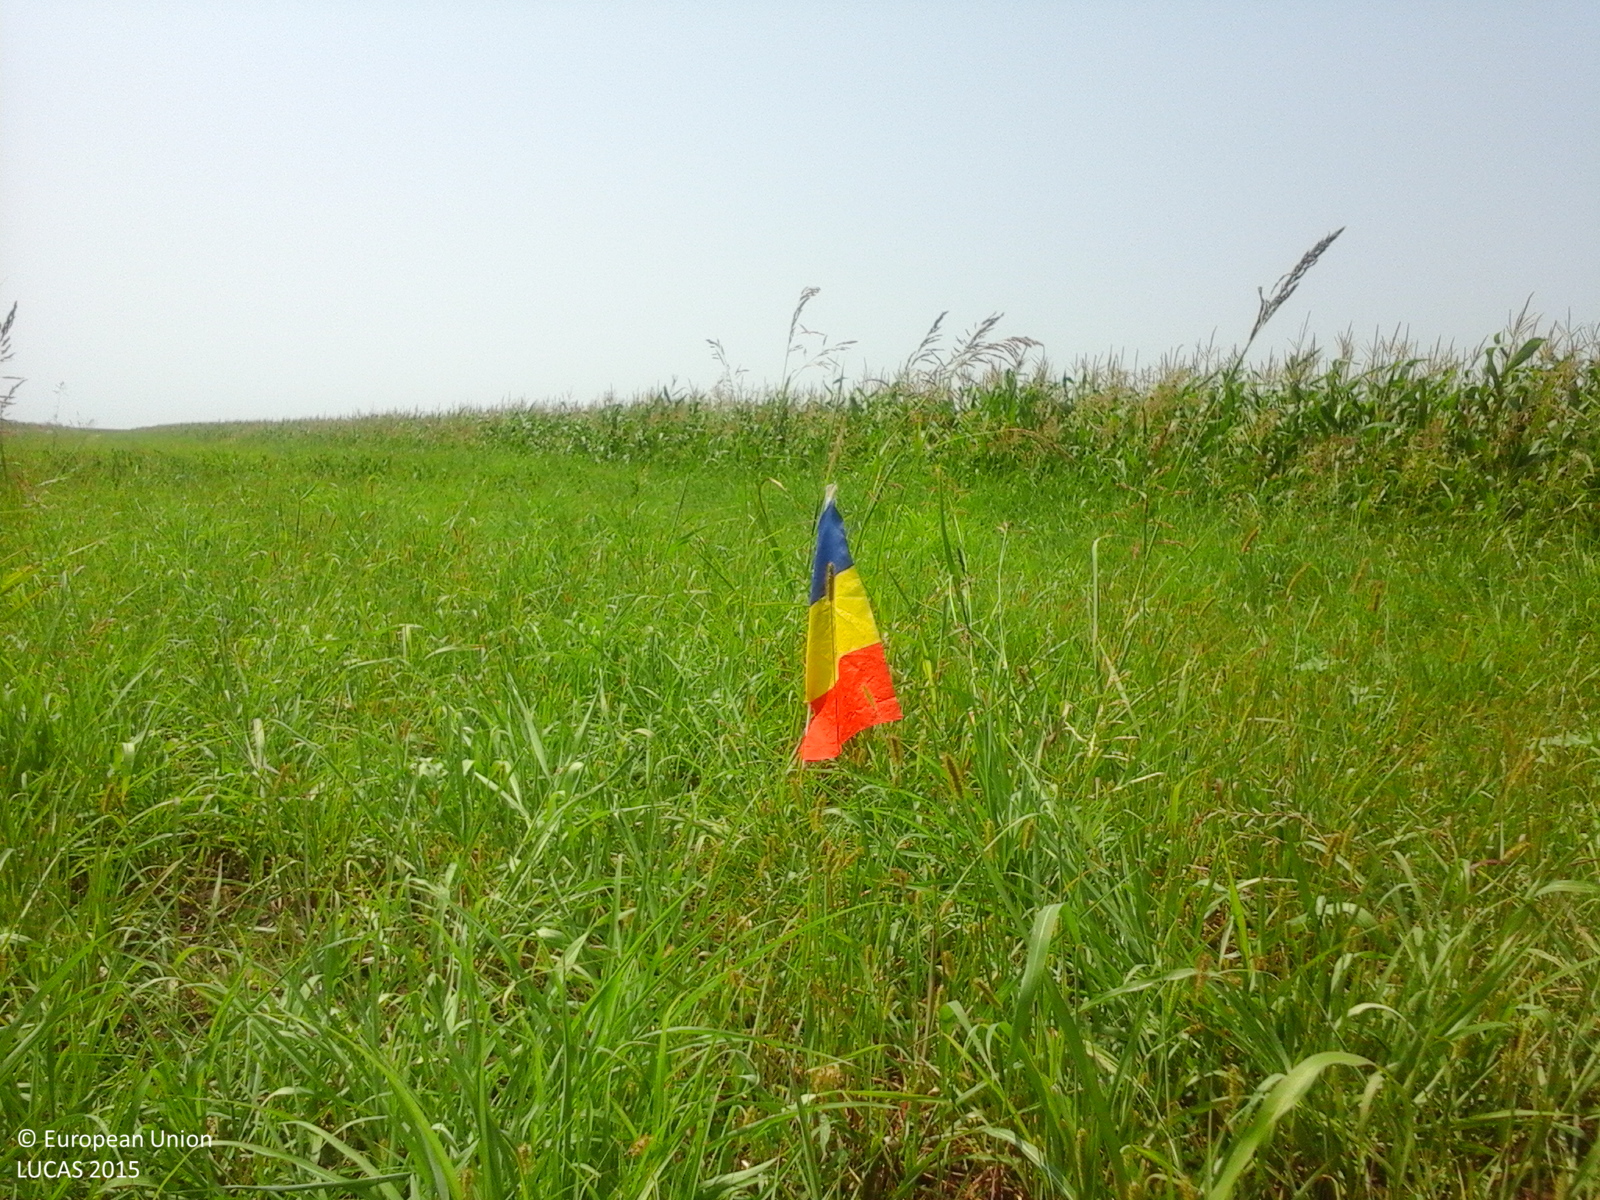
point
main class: Grassland
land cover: Grassland without tree/shrub cover
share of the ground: > 75 %
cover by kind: herbaceous plants 100 %
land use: Agriculture (excluding fallow land and kitchen gardens)
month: July
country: RO
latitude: 44.8530
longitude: 26.6357
